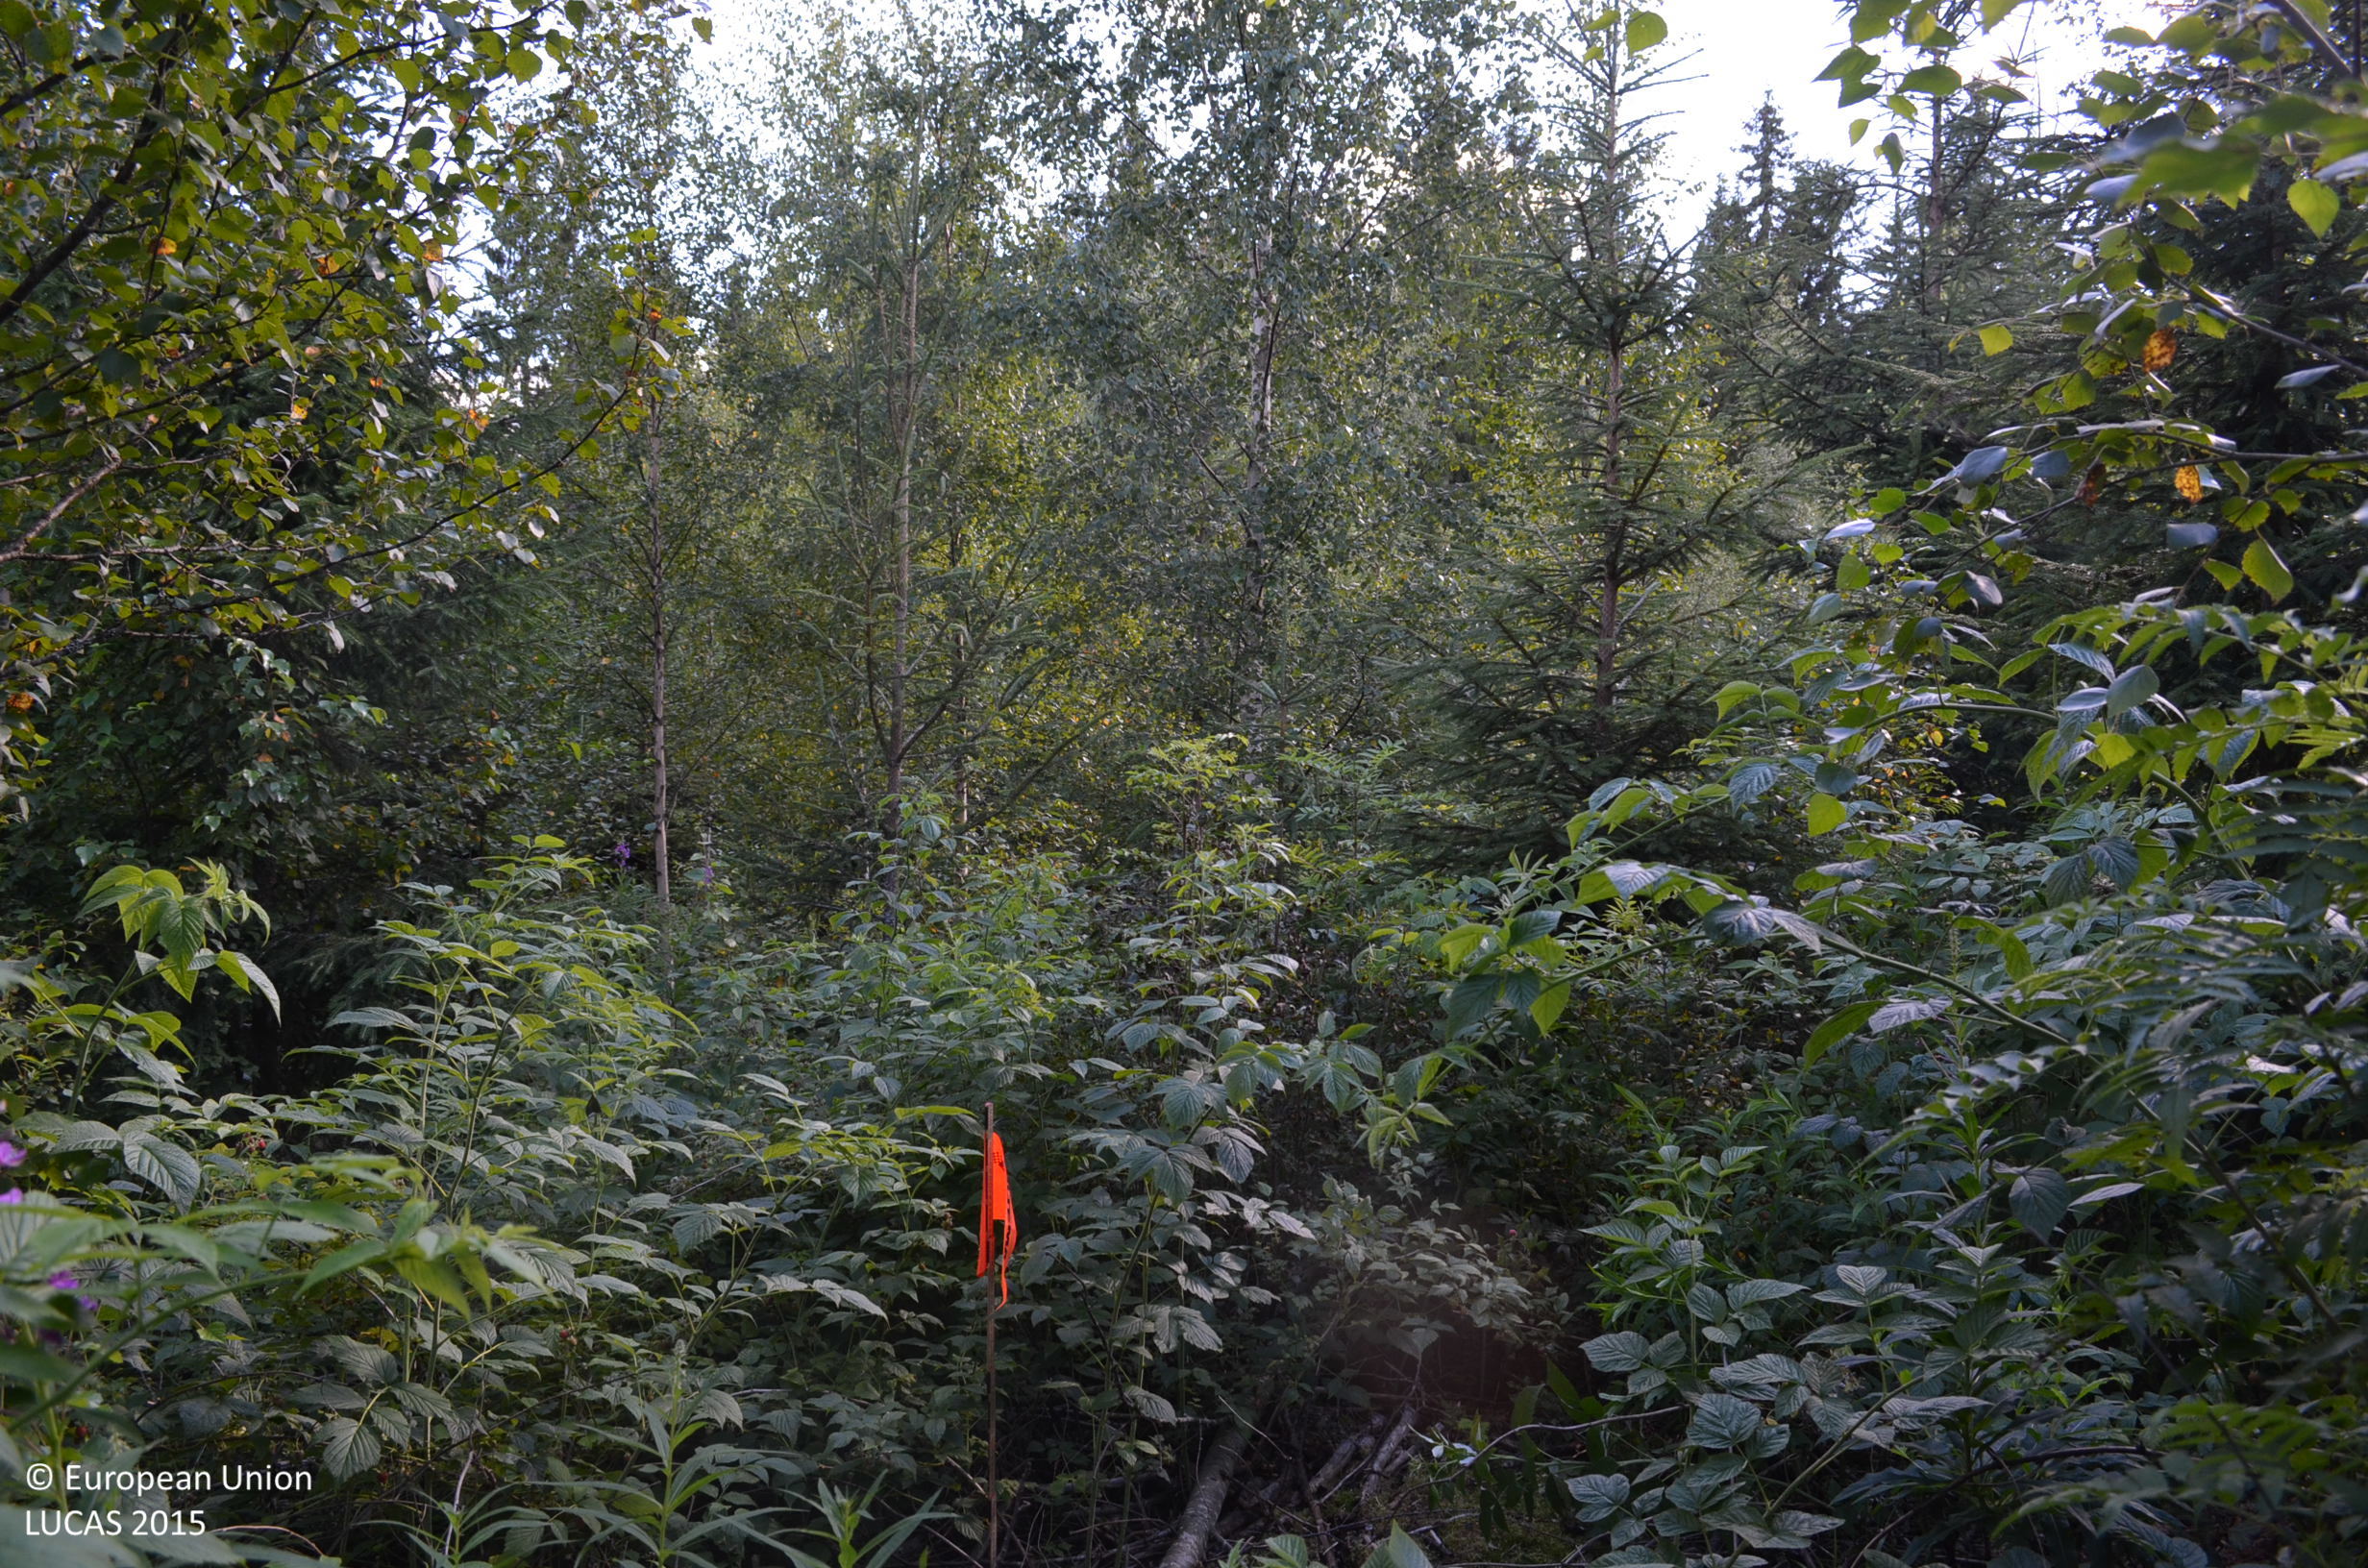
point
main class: Woodland
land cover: Spruce dominated mixed woodland
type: boreal forest
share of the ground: > 75 %
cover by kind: broadleaved forest trees 40 %, coniferous forest trees 35 %, shrubs 20 %, herbaceous plants 5 %
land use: Forestry
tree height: < 5 m
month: August
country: FI
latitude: 61.5945
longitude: 23.1312
